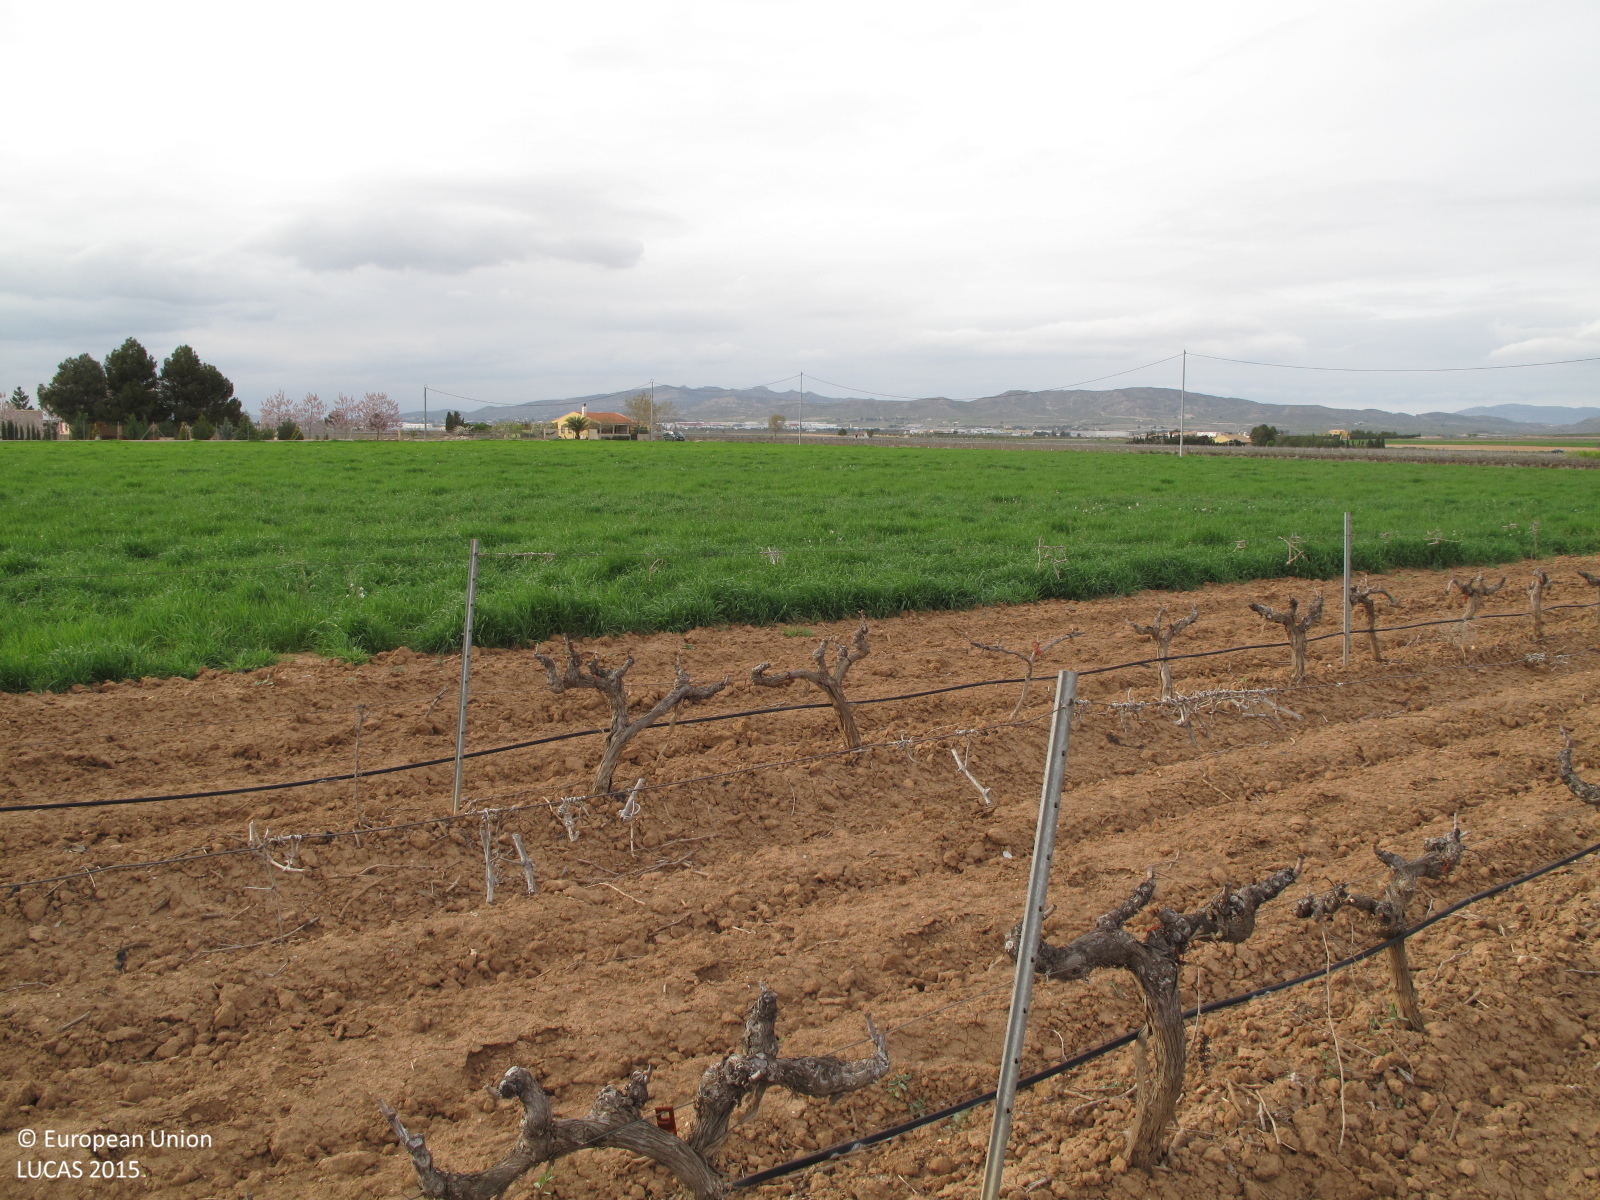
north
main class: Cropland
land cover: Vineyards
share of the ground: < 10 %
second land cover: Other bare soil
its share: > 75 %
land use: Agriculture (excluding fallow land and kitchen gardens)
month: April
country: ES
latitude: 38.5827
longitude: -1.0453
